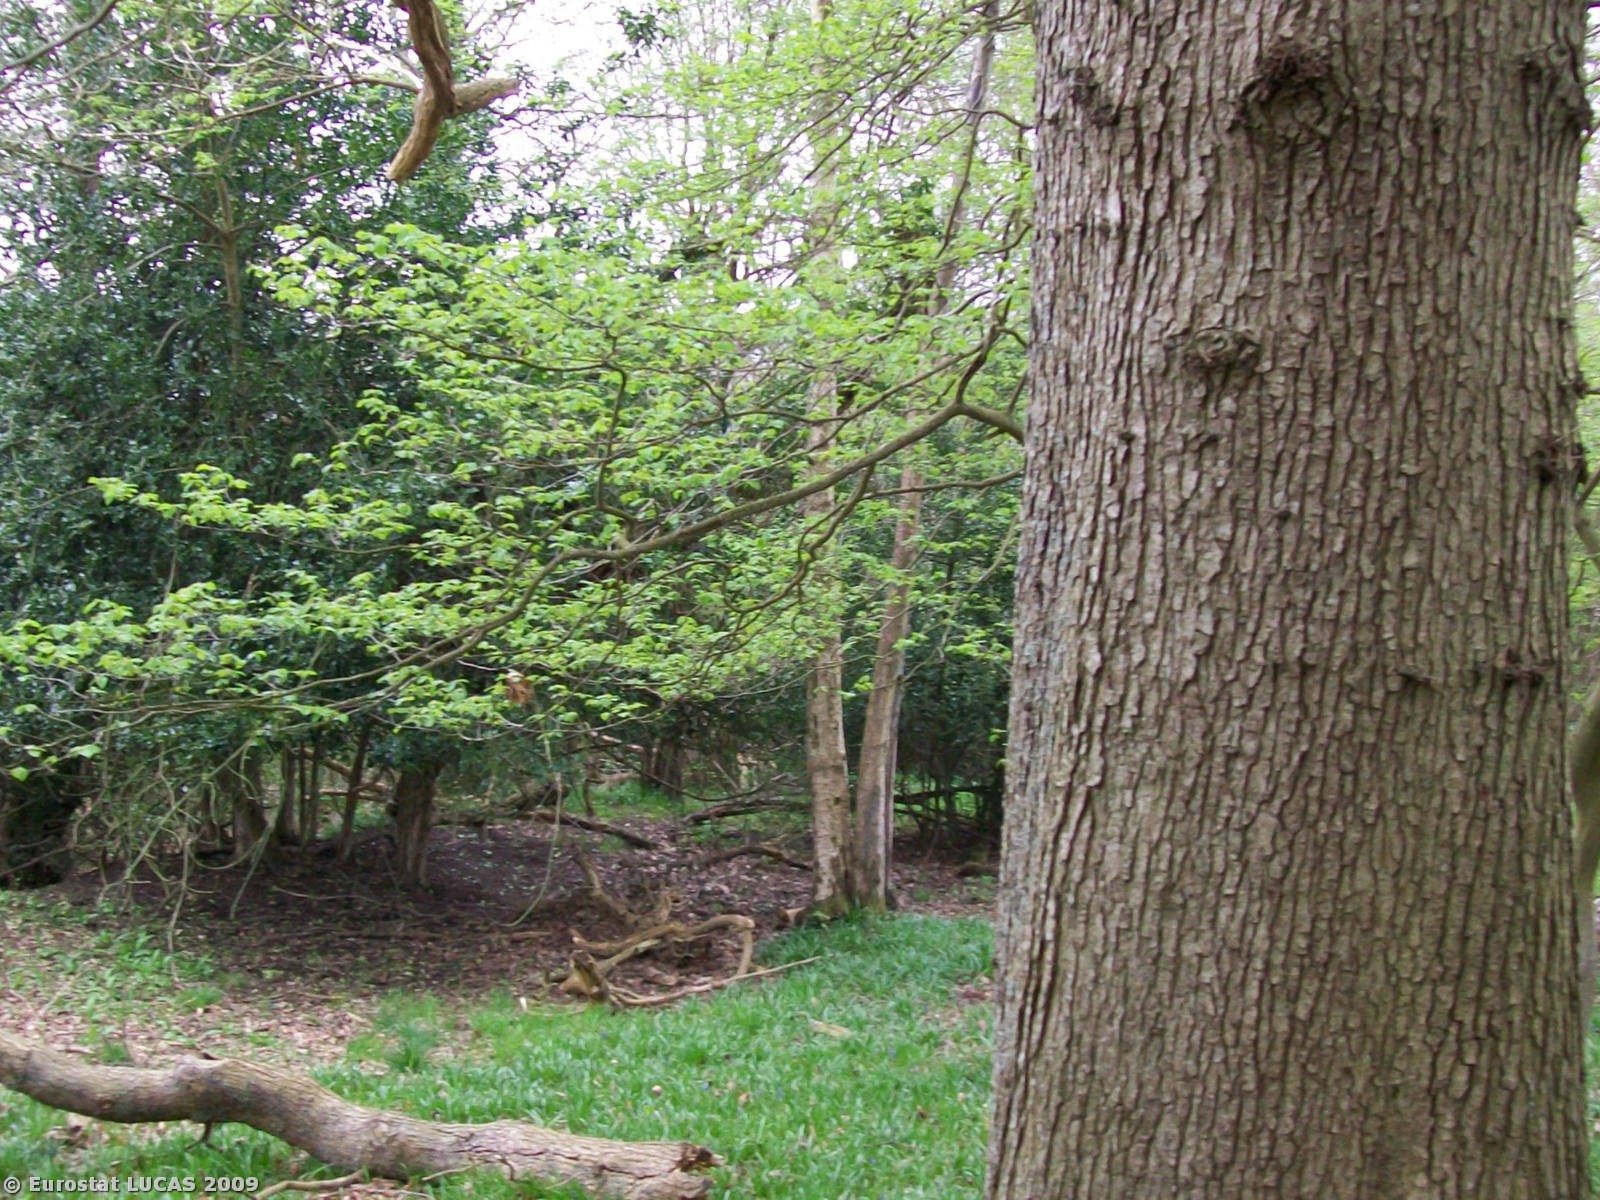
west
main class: Woodland
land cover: Mixed woodland
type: mesophytic deciduous forest
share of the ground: > 75 %
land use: Forestry
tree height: > 5 m
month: April
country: GB
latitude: 50.9523
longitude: 0.3622
